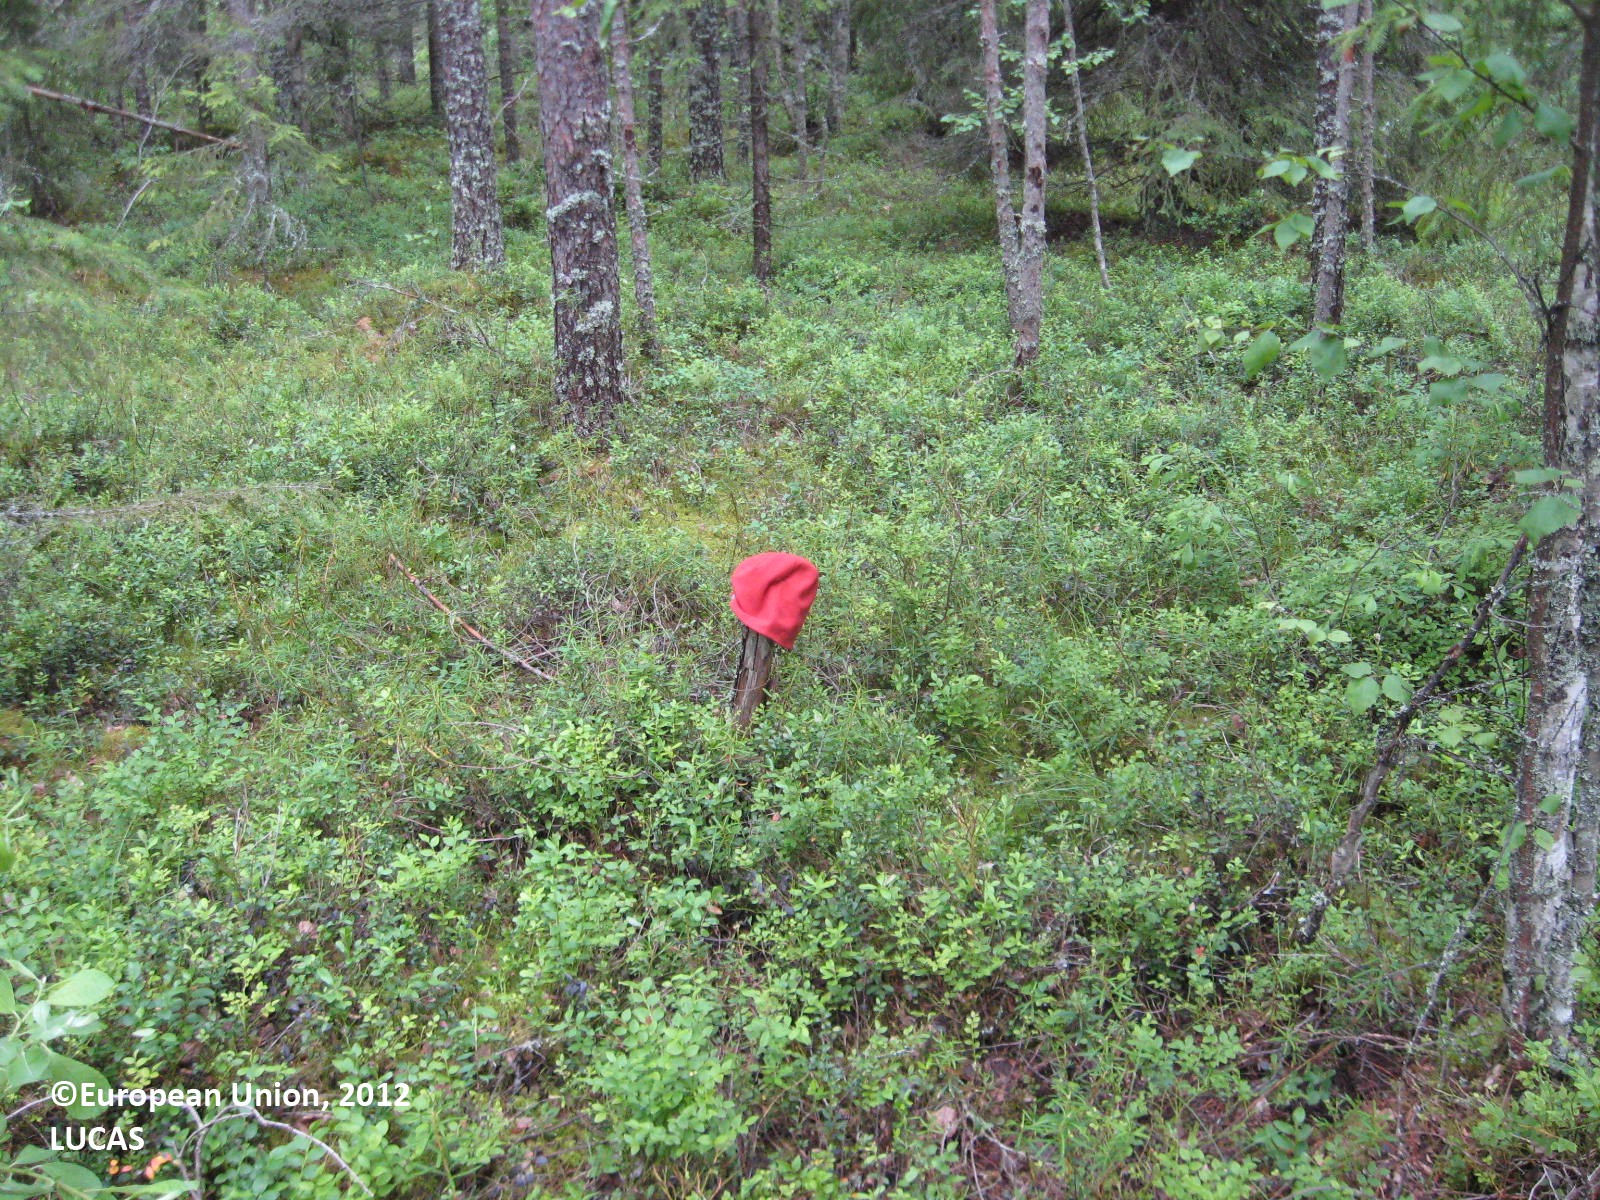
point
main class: Woodland
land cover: Pine dominated coniferous woodland
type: boreal forest
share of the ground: > 75 %
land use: Forestry
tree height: > 5 m
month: July
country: FI
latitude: 62.4341
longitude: 22.7470
